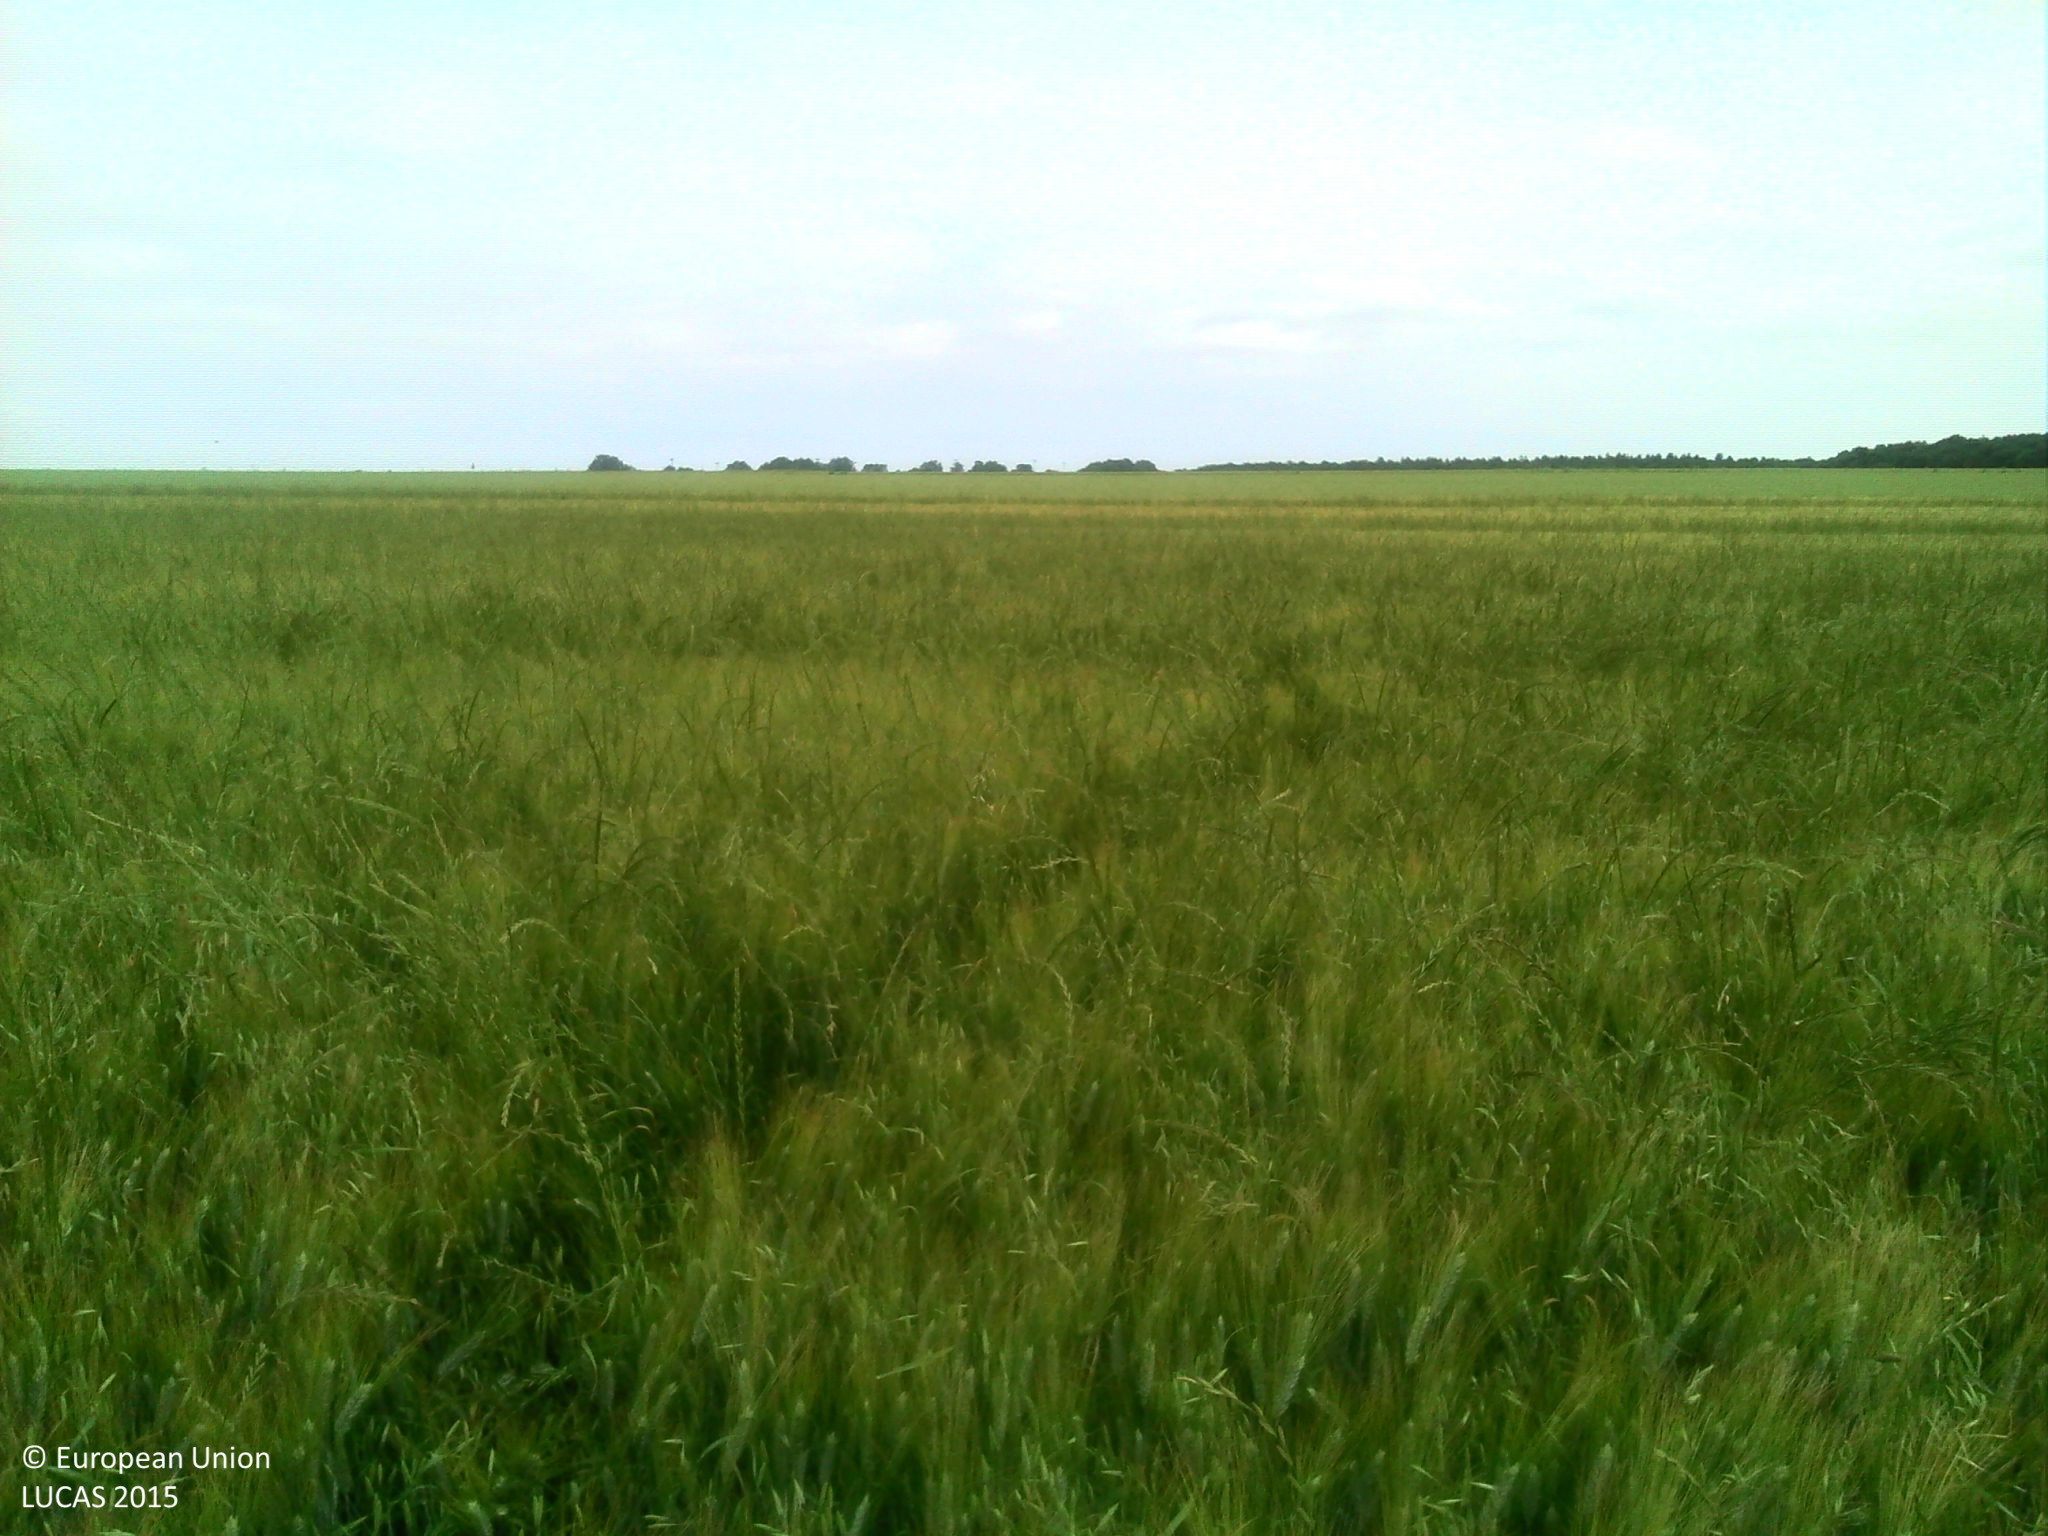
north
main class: Cropland
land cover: Durum wheat
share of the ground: > 75 %
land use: Agriculture (excluding fallow land and kitchen gardens)
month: June
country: FR
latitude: 46.1334
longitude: -0.9408
